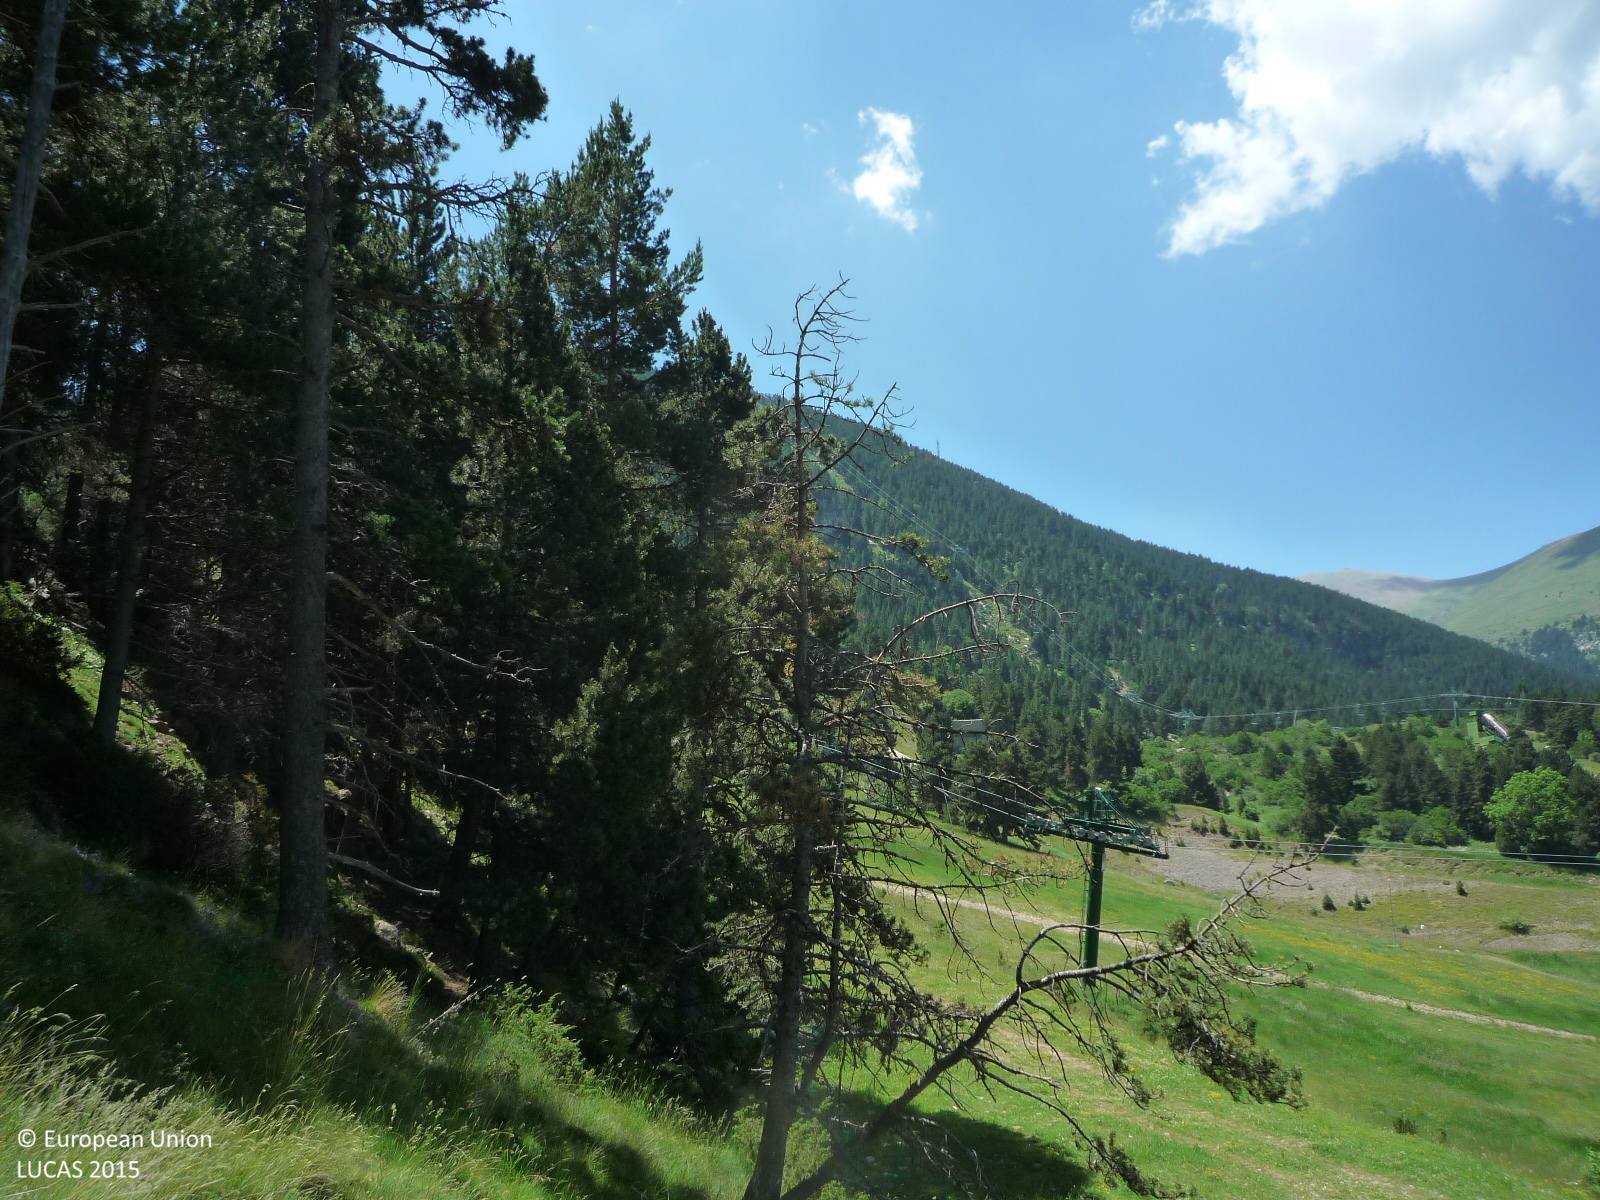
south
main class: Woodland
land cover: Pine dominated coniferous woodland
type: alpine coniferous forest
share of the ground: > 75 %
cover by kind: coniferous forest trees 80 %, shrubs 10 %, herbaceous plants 10 %
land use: Sport
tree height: > 5 m
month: June
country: ES
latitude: 42.3325
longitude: 1.9412
